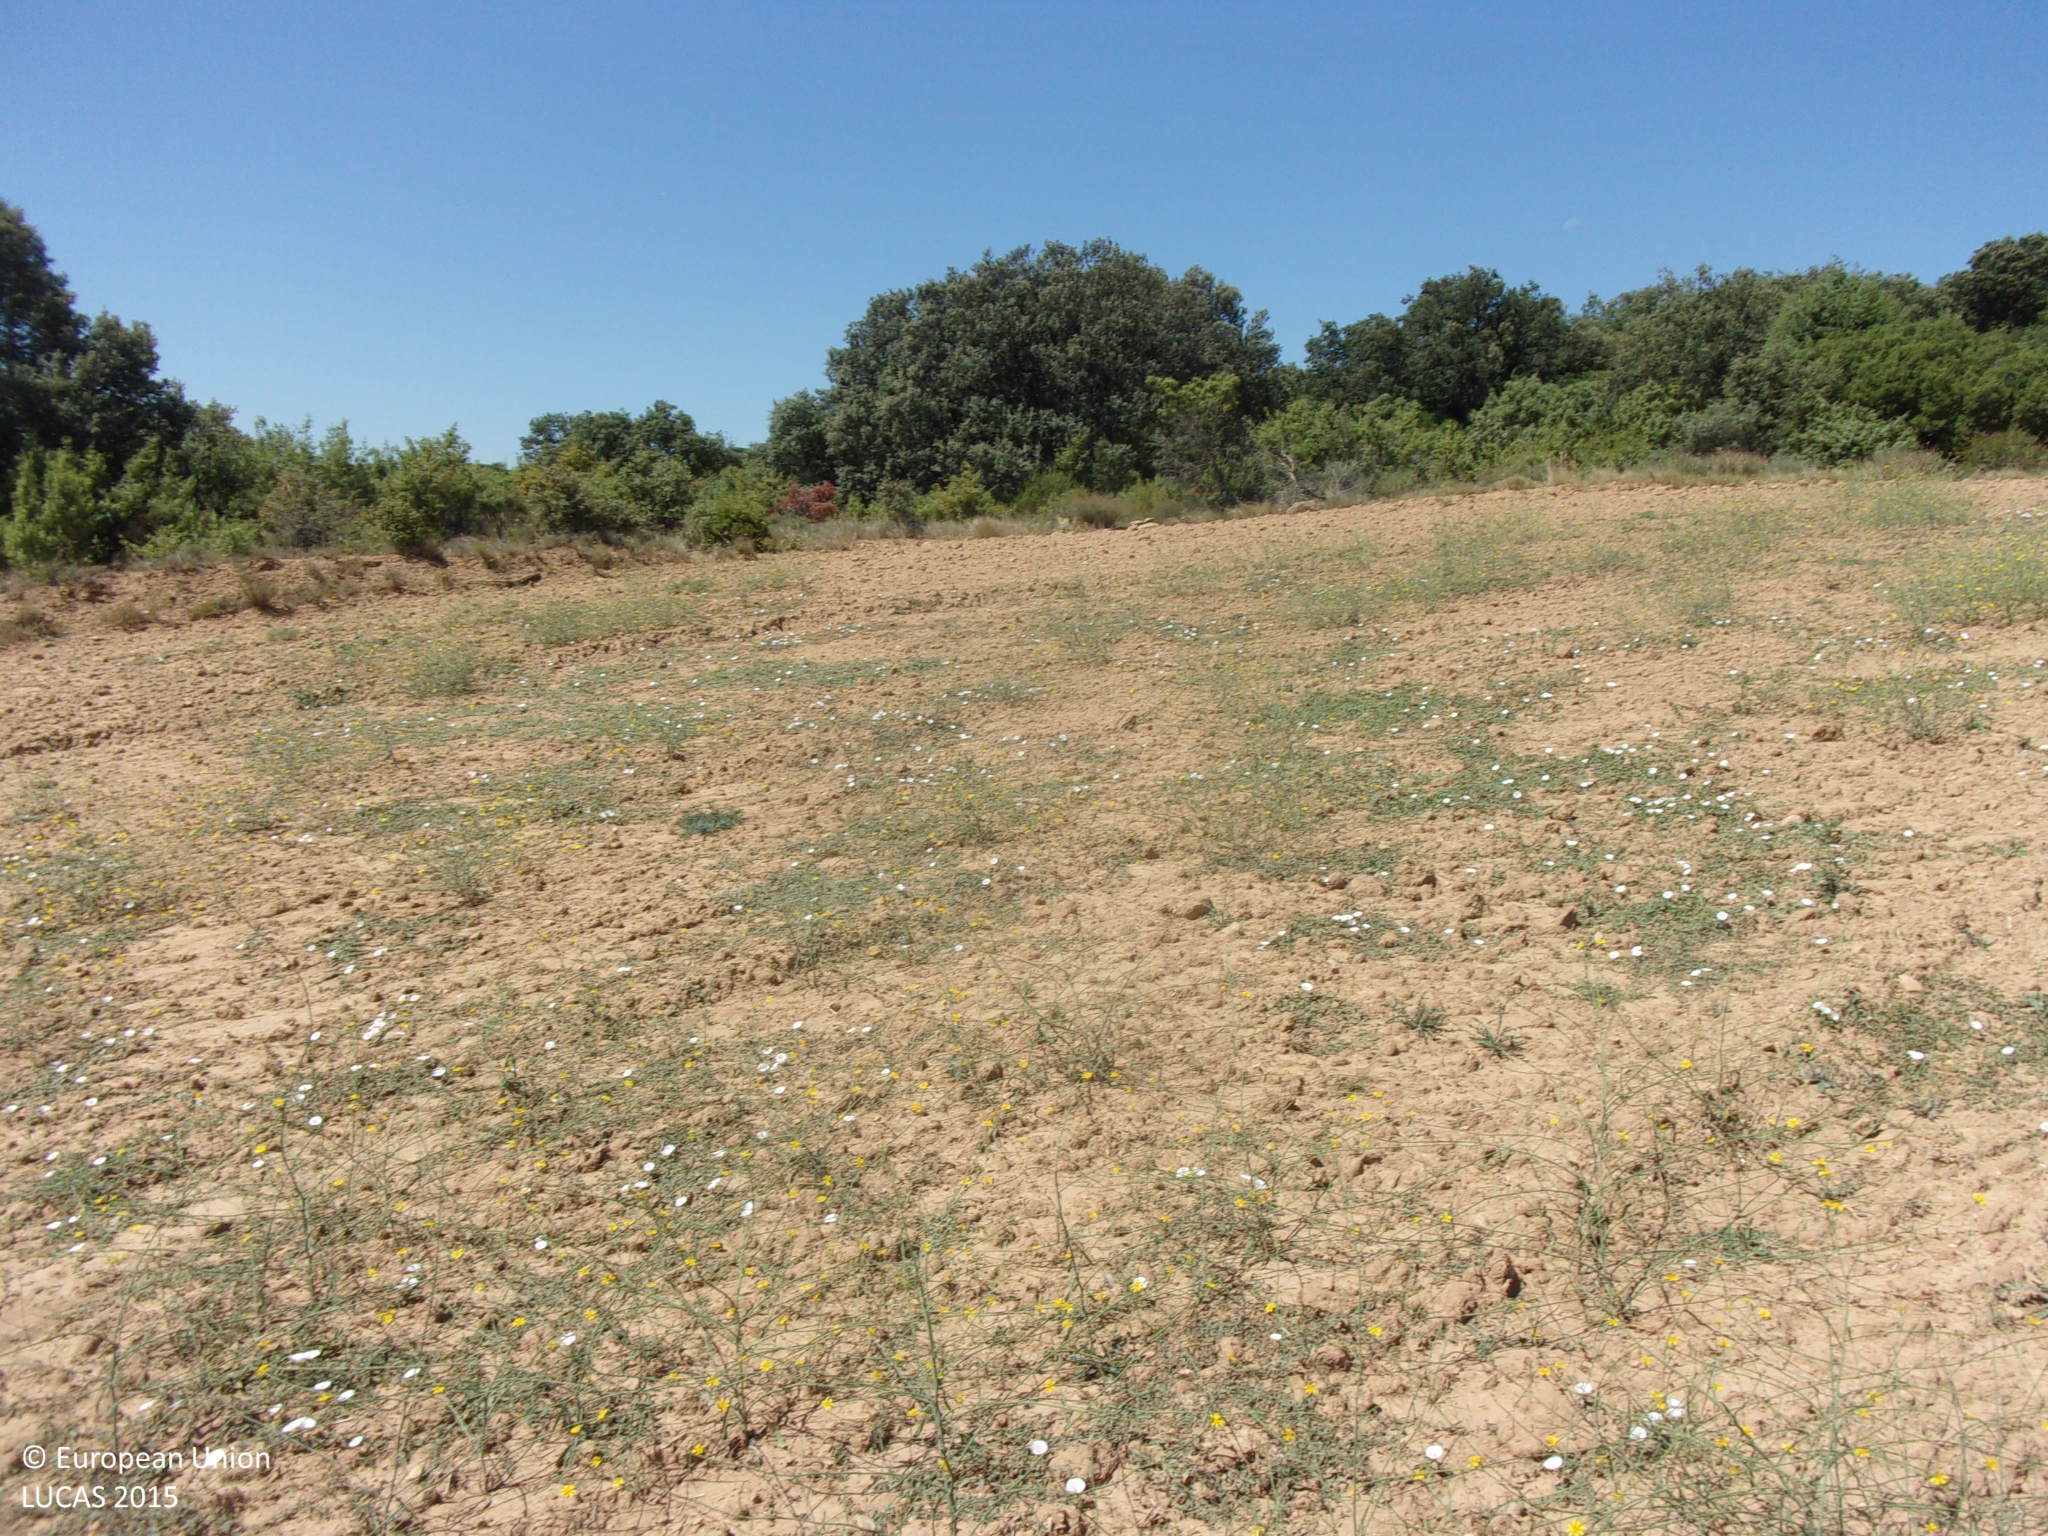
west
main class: Grassland
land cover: Spontaneously vegetated surfaces
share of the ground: 25 - 50 %
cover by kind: unconsolidated bare surface 70 %, herbaceous plants 30 %
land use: Fallow land
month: August
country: ES
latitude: 42.3600
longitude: -1.1887
